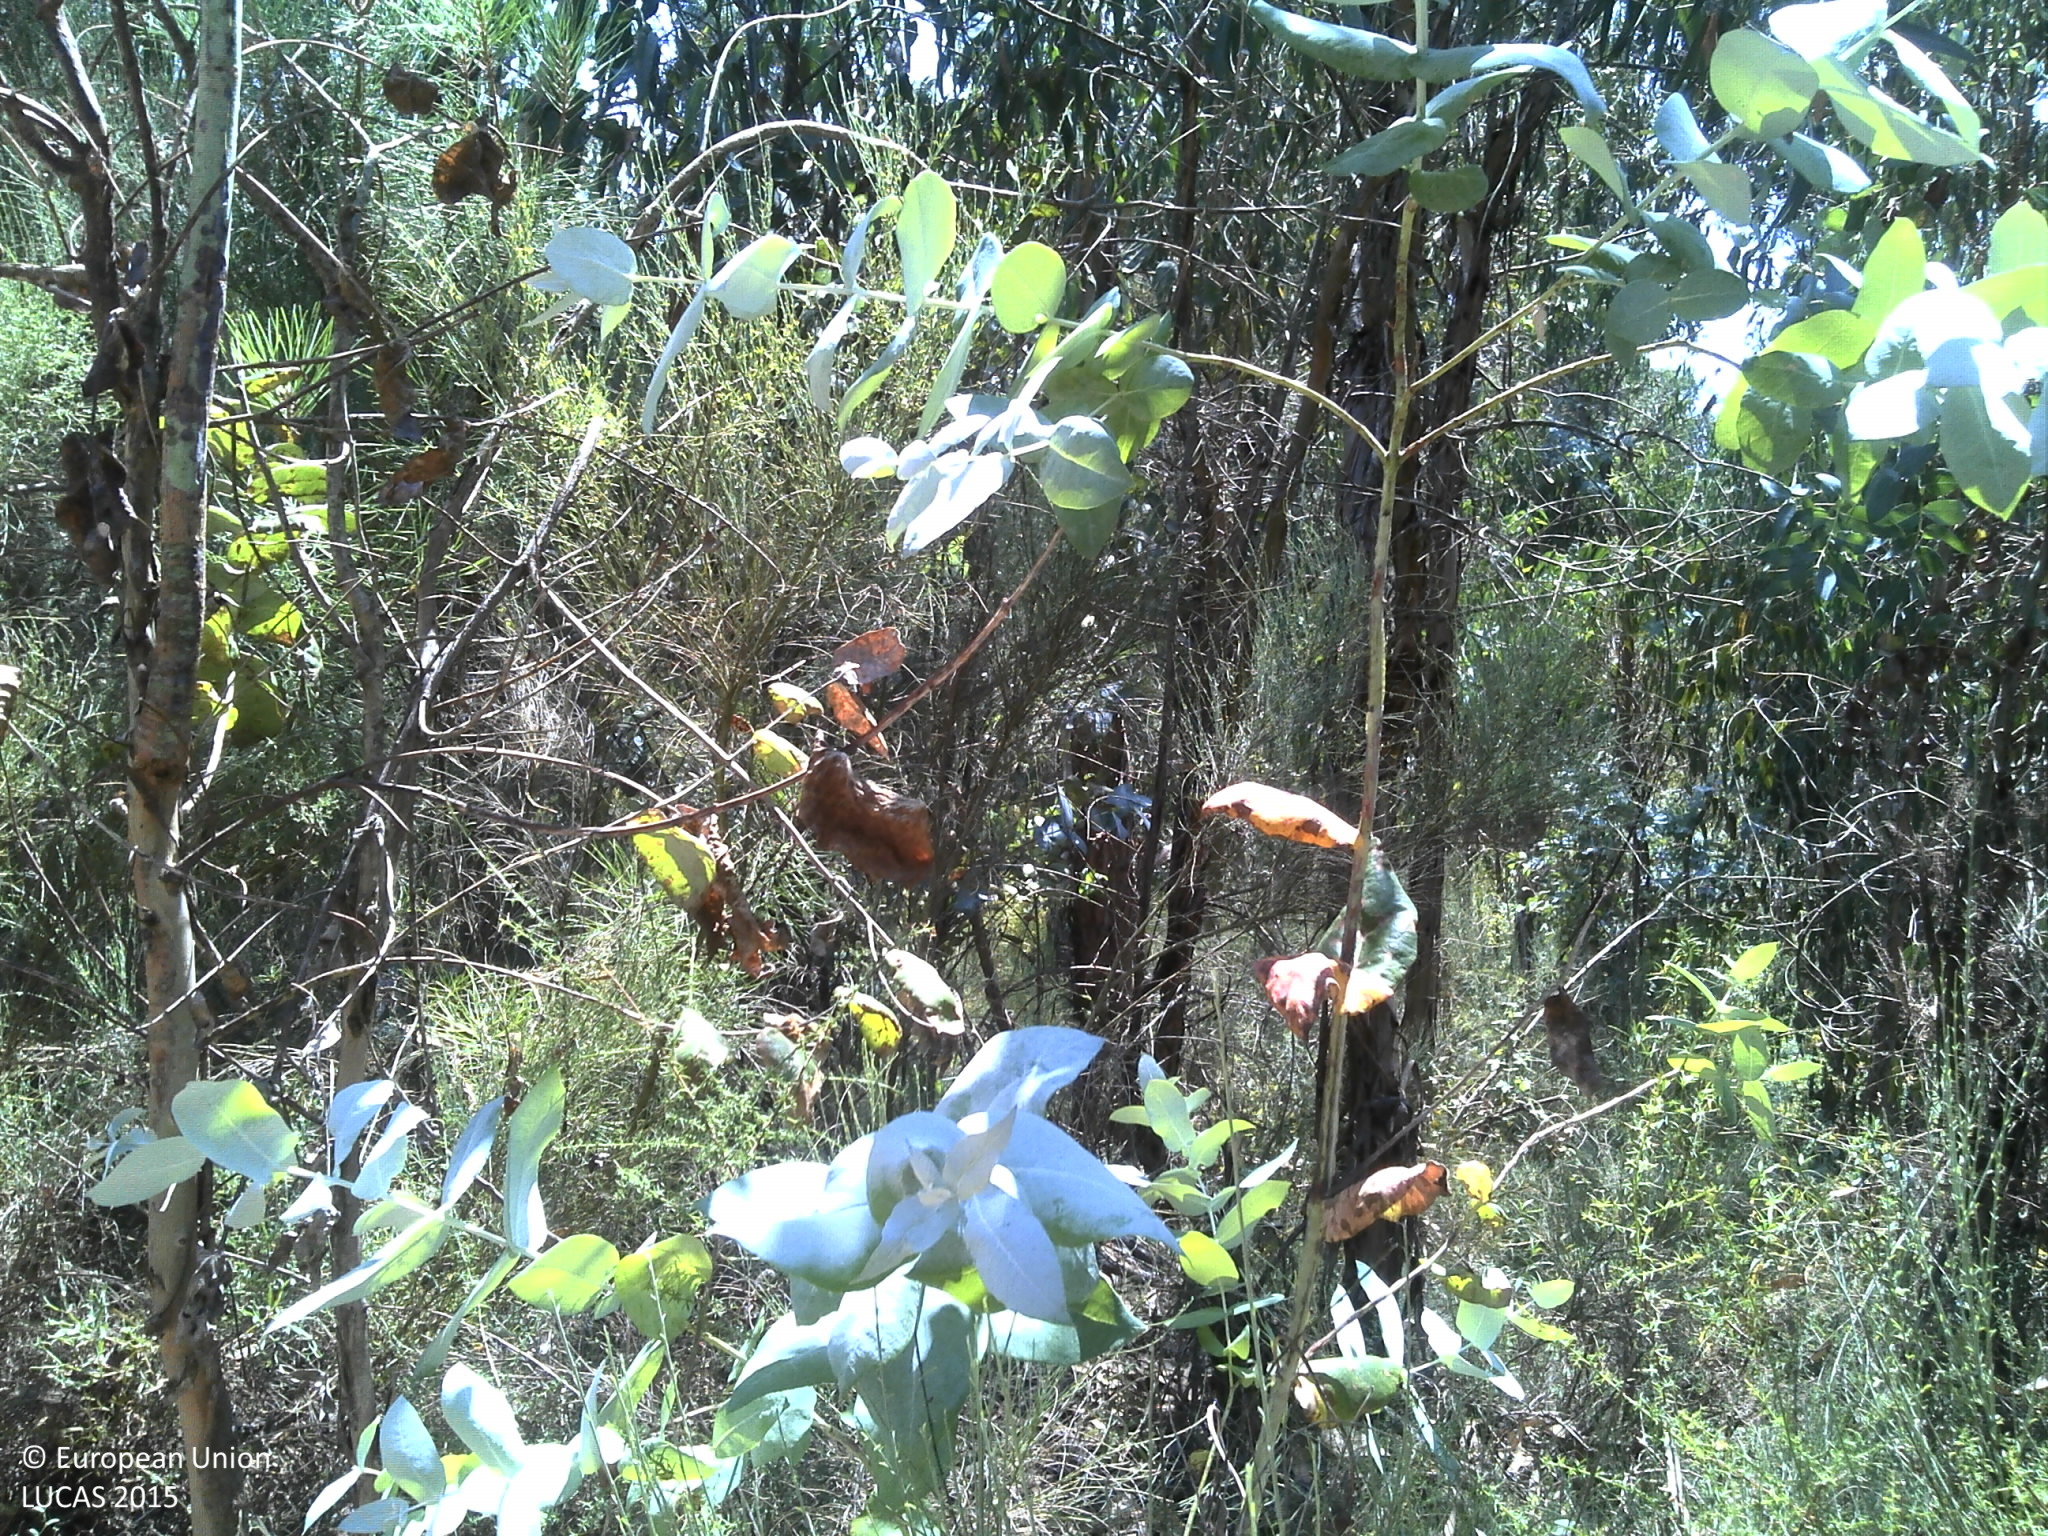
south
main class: Woodland
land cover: Broadleaved woodland
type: exotic forest
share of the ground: 50 - 75 %
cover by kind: broadleaved forest trees 75 %, shrubs 20 %, unconsolidated bare surface 5 %
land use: Forestry
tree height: > 5 m
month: July
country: PT
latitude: 40.4029
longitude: -7.9725
